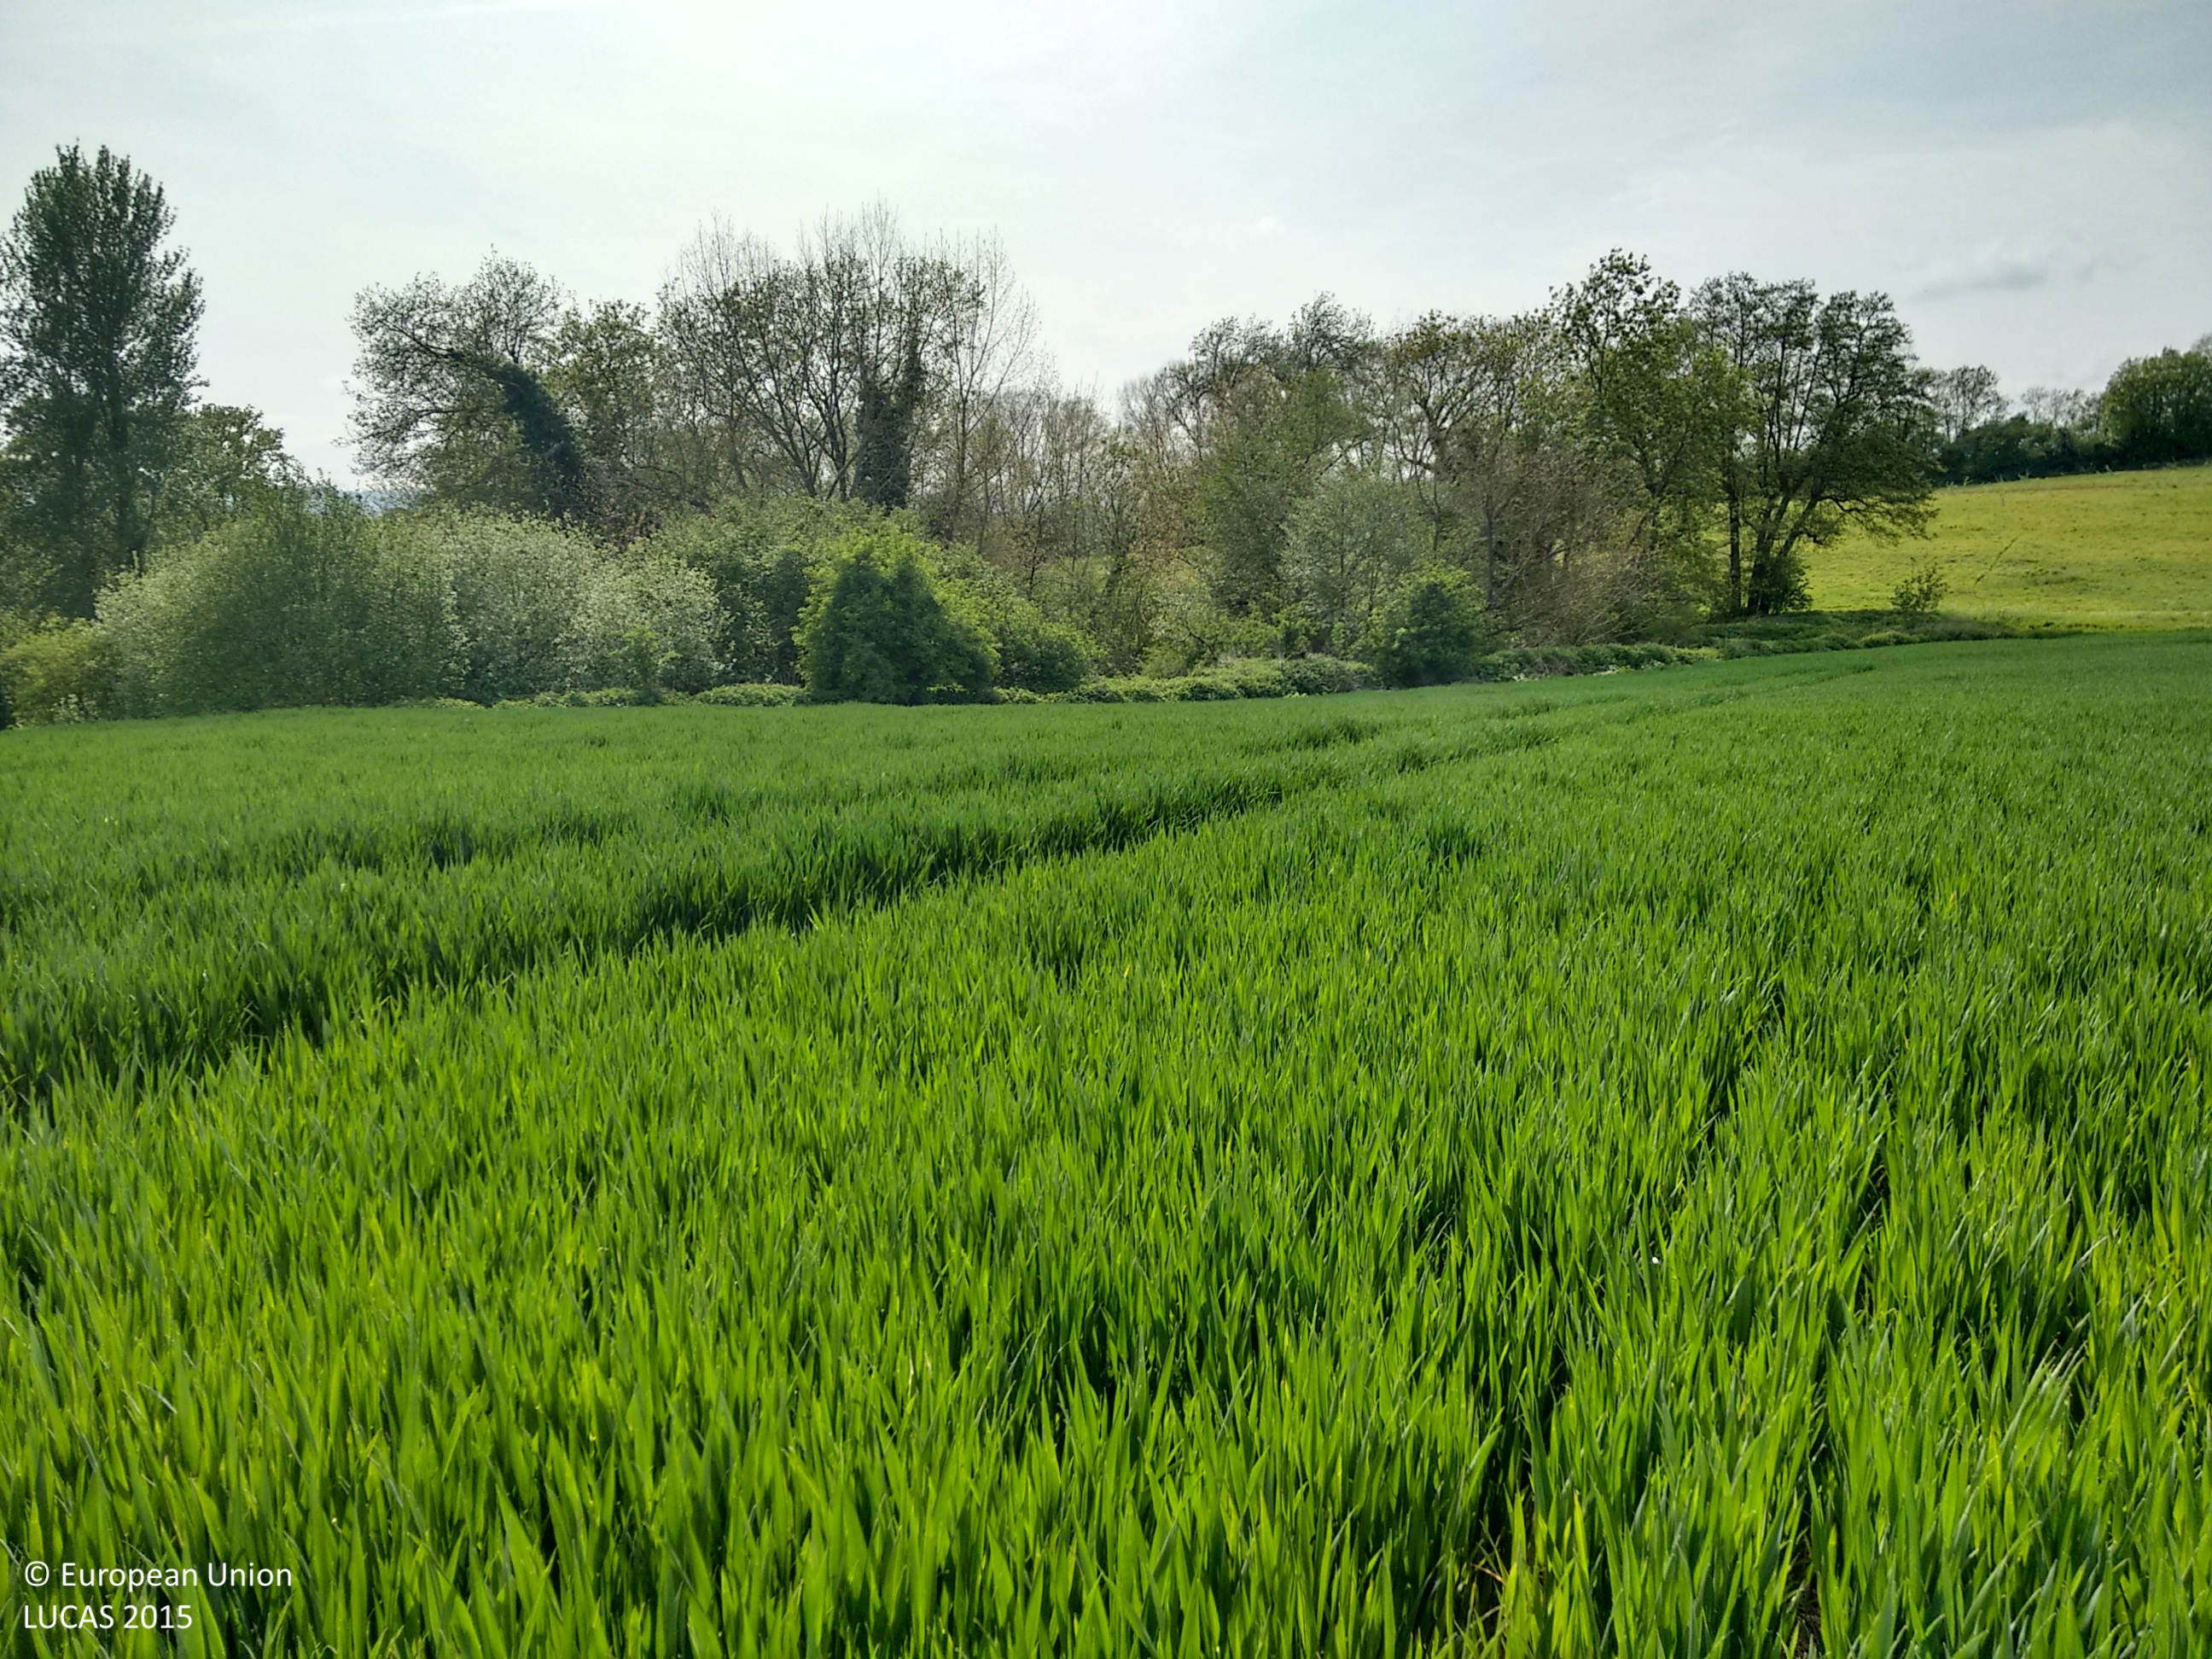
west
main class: Cropland
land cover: Barley
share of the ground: > 75 %
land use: Agriculture (excluding fallow land and kitchen gardens)
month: May
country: GB
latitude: 51.2310
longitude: 0.4481
